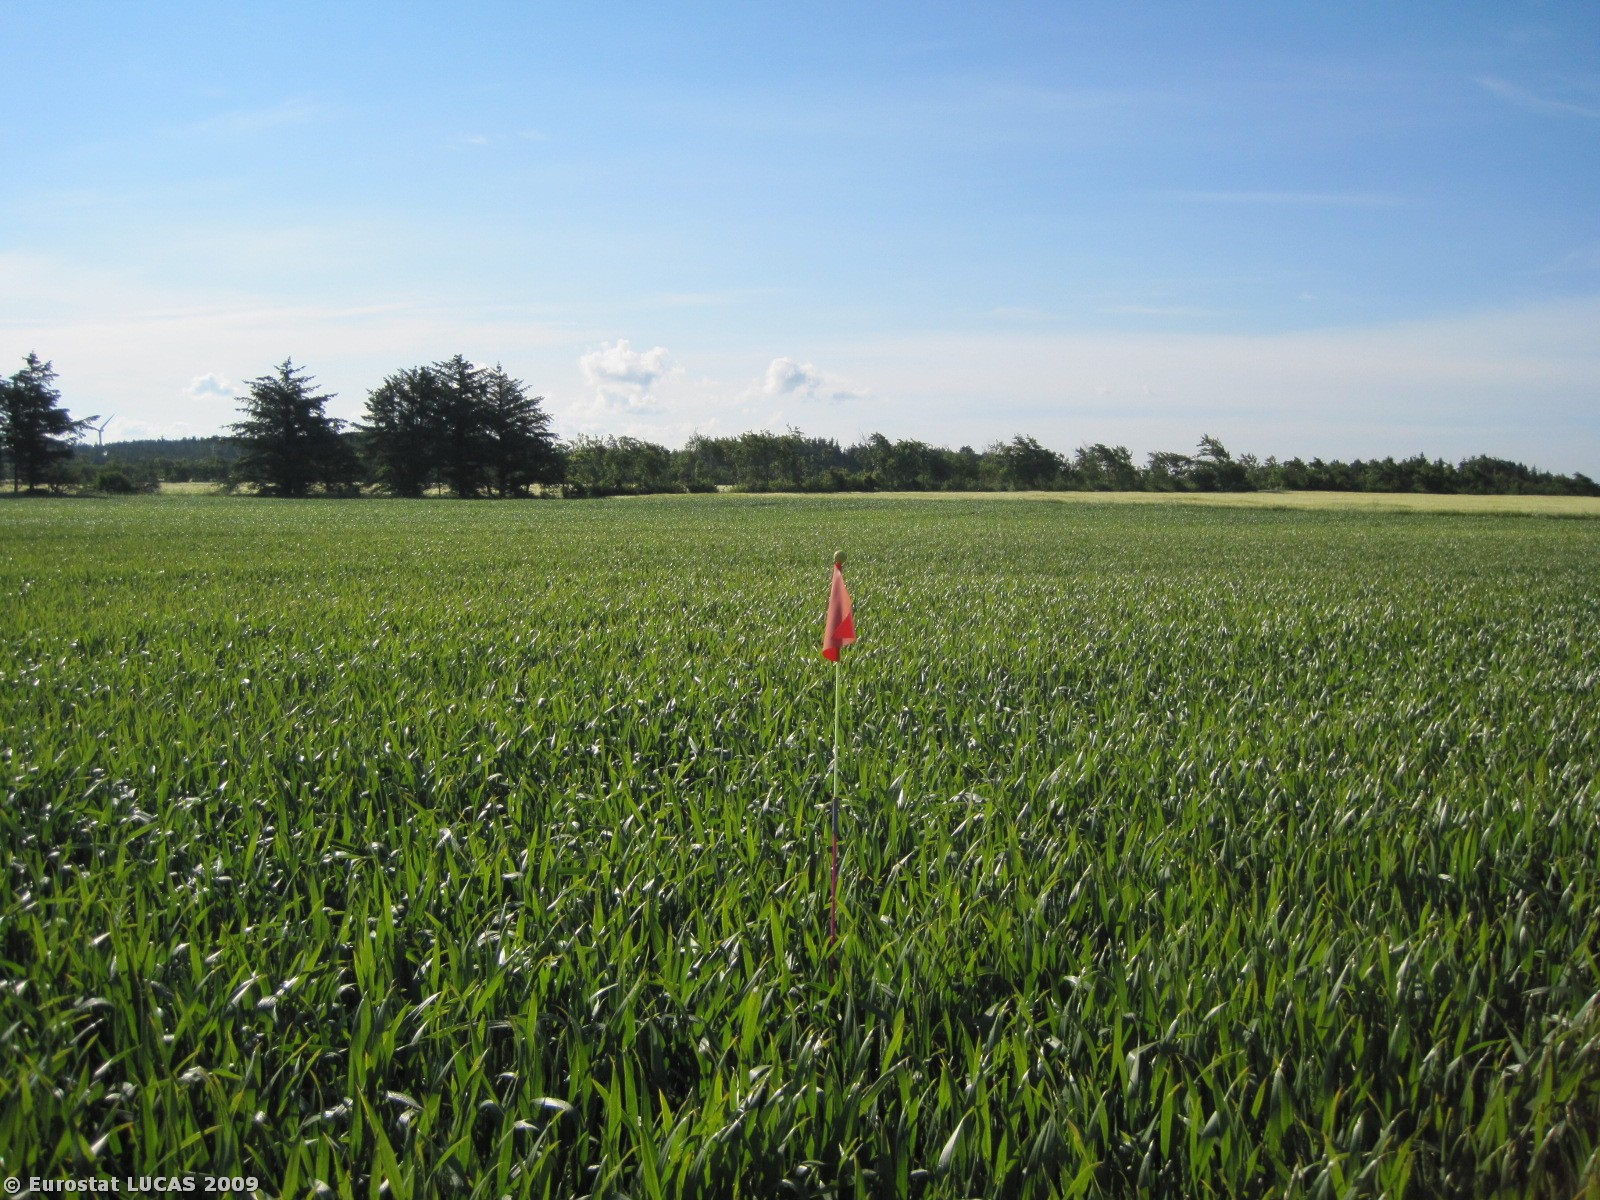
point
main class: Cropland
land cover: Common wheat
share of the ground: > 75 %
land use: Agriculture (excluding fallow land and kitchen gardens)
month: June
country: DK
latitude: 57.4641
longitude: 9.8502
